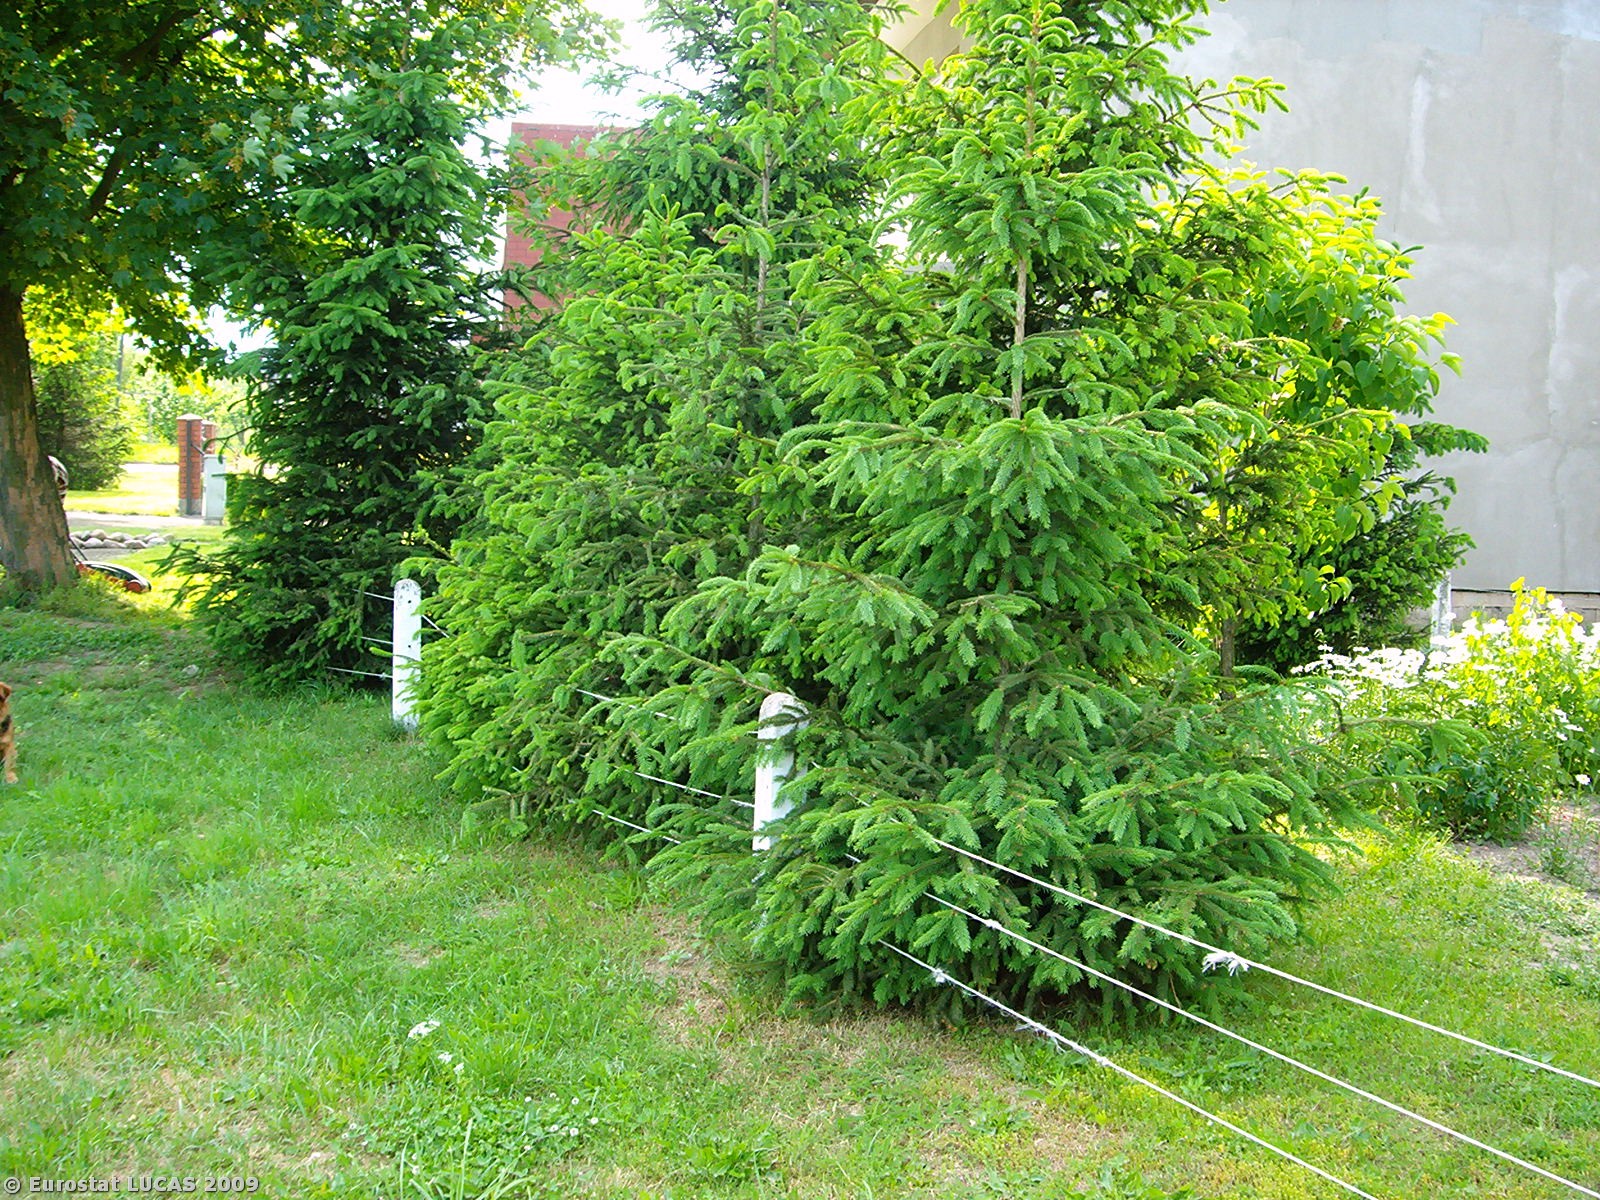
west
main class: Grassland
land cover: Grassland without tree/shrub cover
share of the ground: > 75 %
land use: Residential
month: May
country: PL
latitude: 52.4973
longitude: 16.3259
